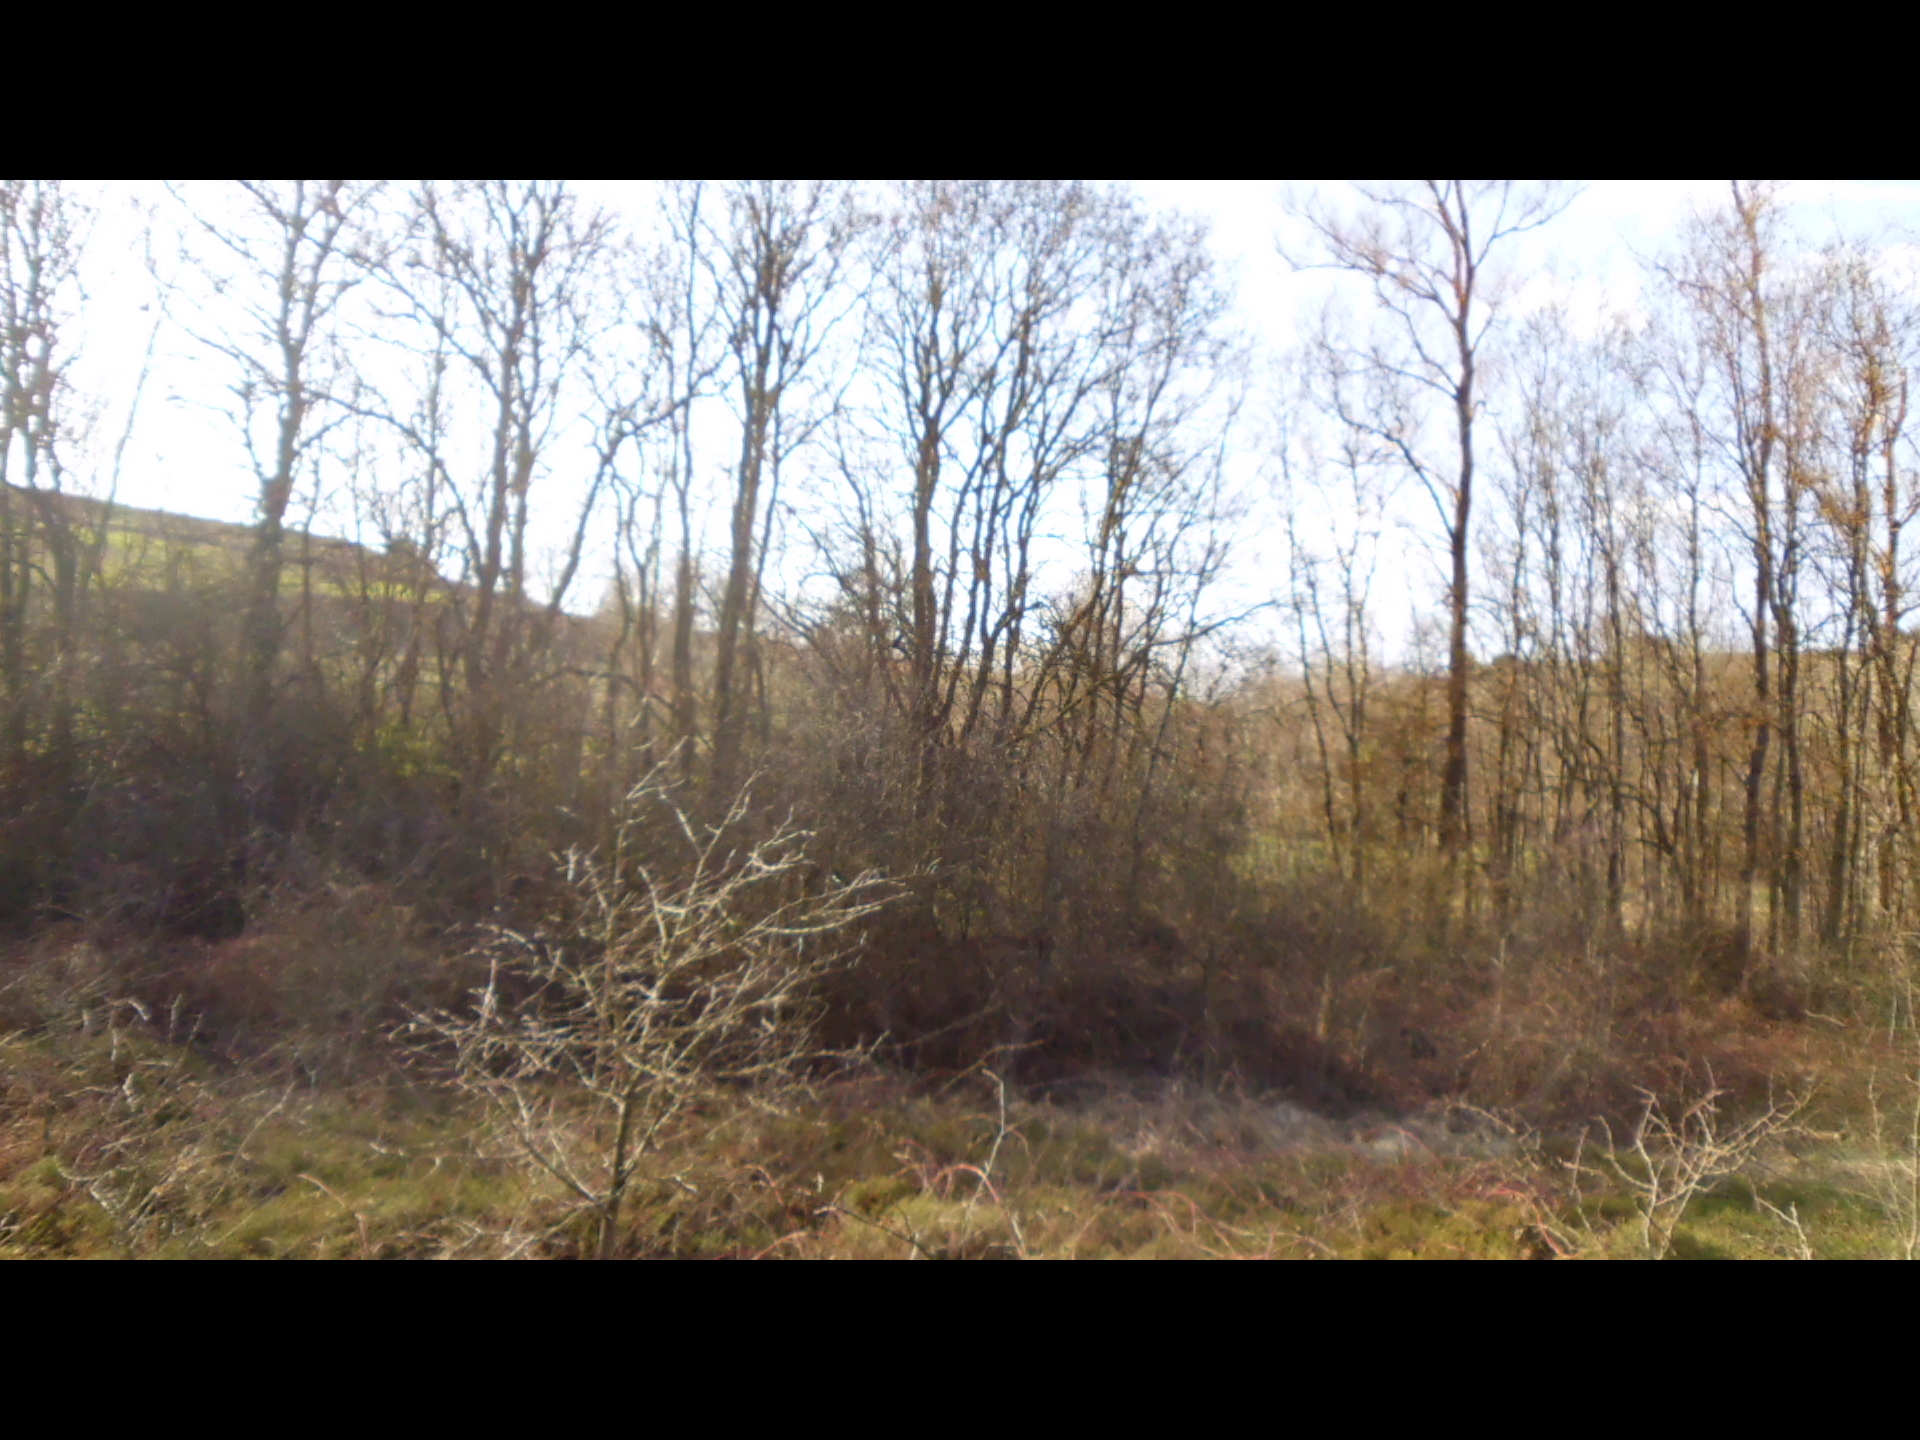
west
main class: Shrubland
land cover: Shrubland without tree cover
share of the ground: 50 - 75 %
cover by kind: herbaceous plants 65 %, shrubs 35 %
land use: Semi-natural and natural areas not in use
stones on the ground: 25 - 50 %
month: April
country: ES
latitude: 42.5927
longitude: -3.7247
